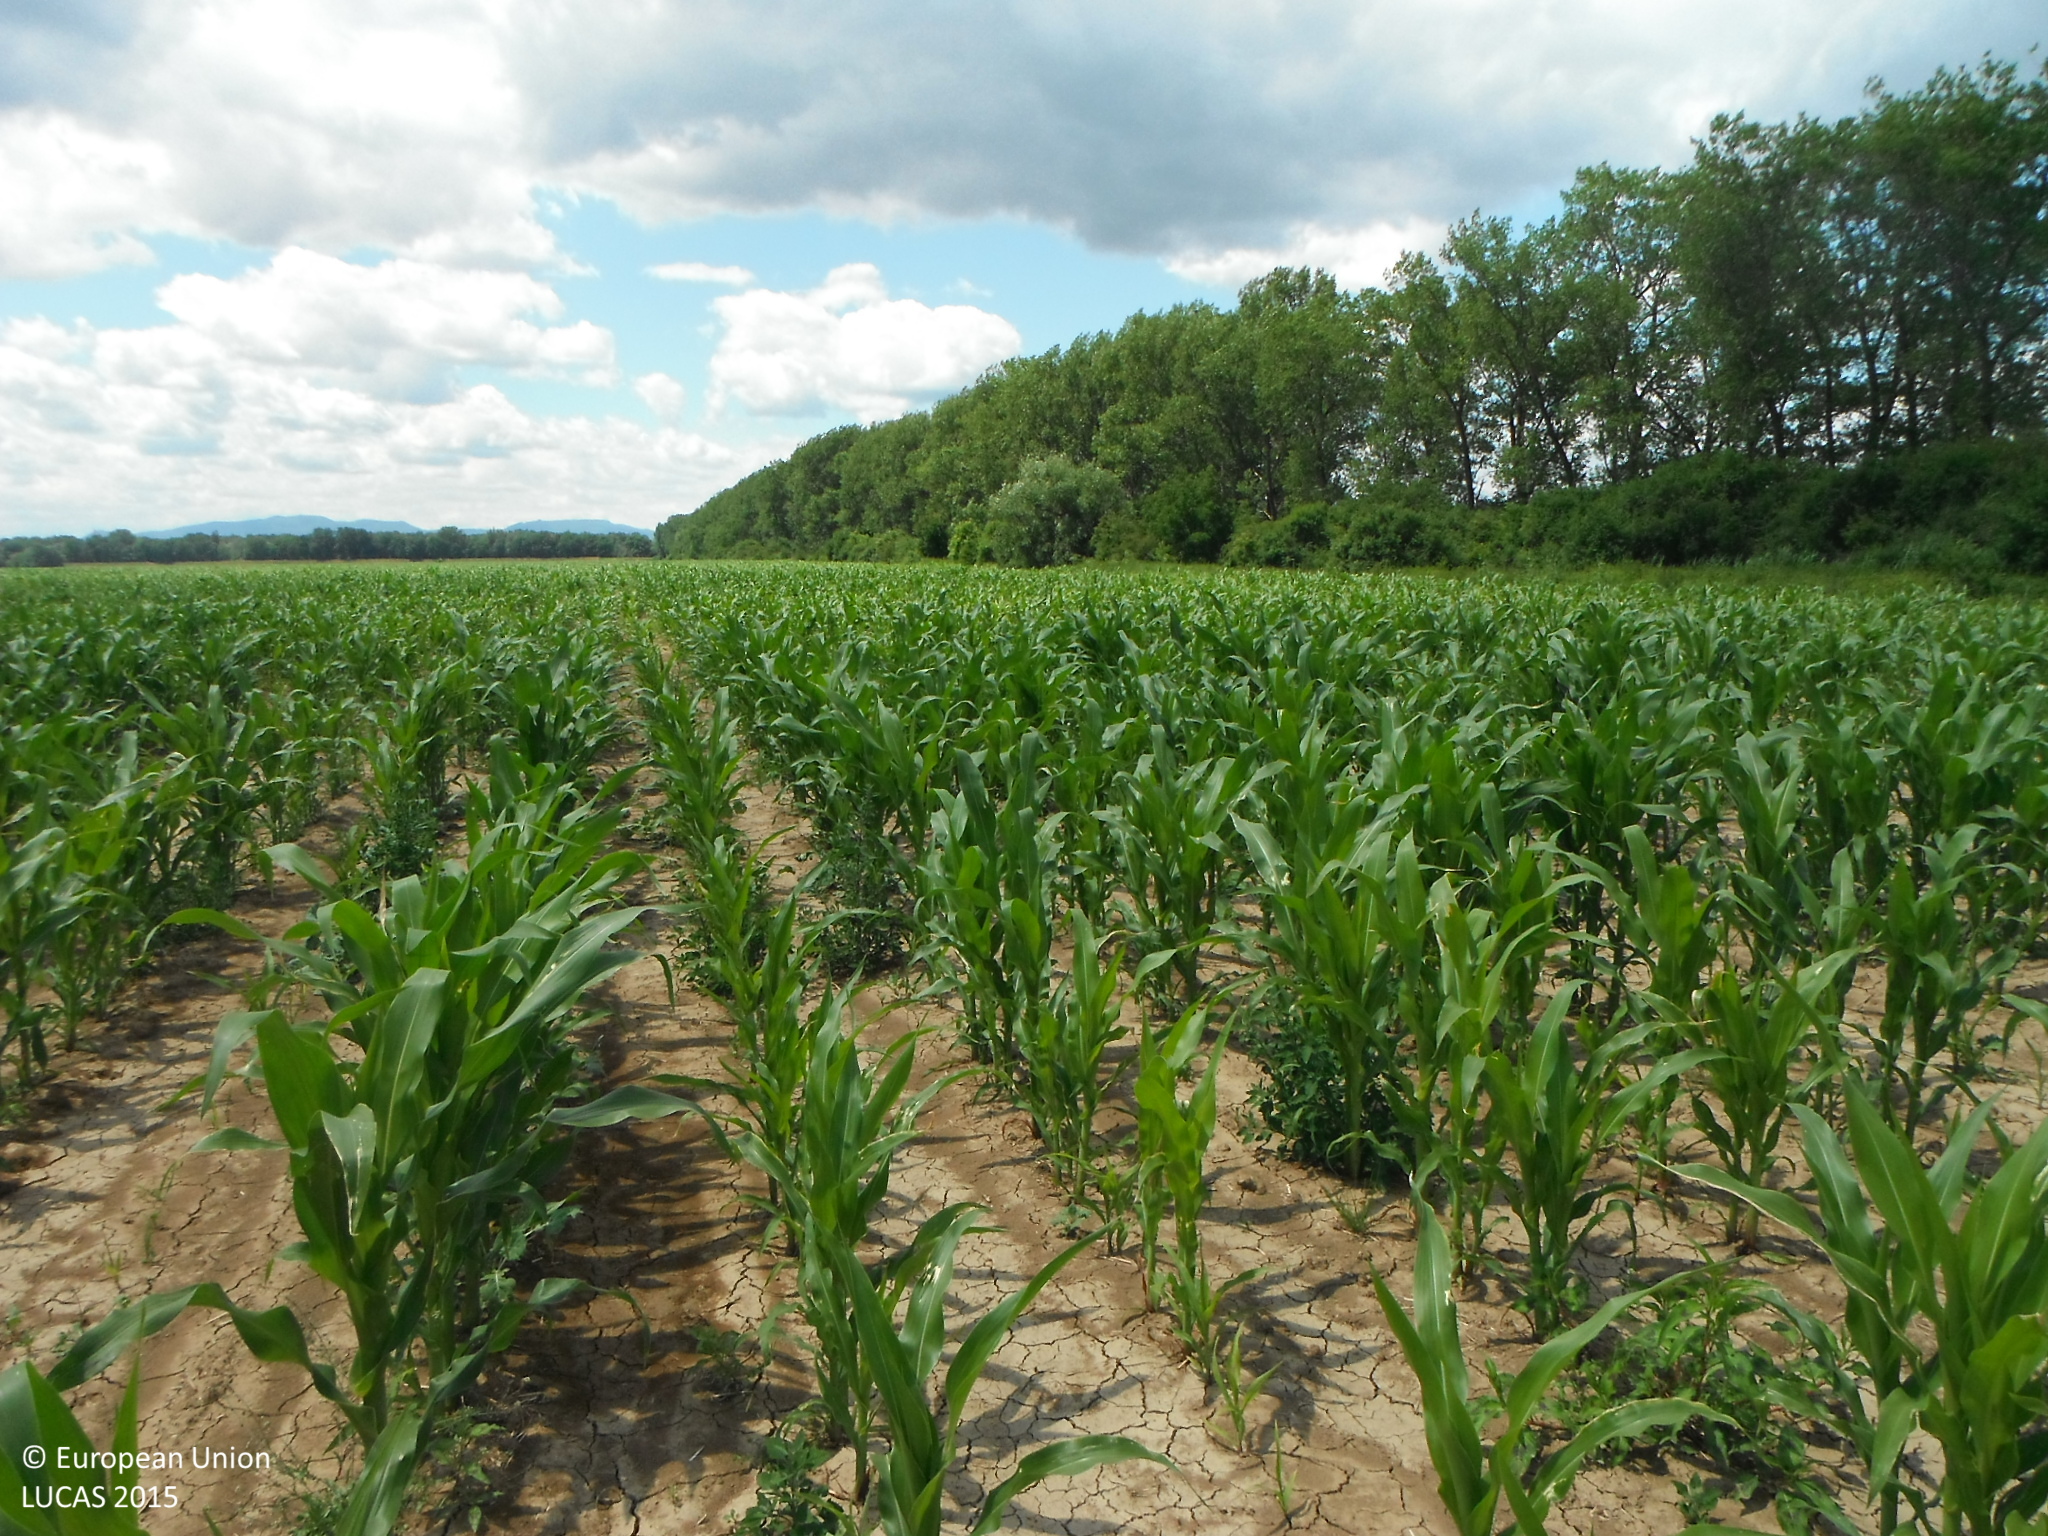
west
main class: Cropland
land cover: Maize
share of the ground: 25 - 50 %
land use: Agriculture (excluding fallow land and kitchen gardens)
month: June
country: SK
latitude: 48.6782
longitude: 21.7997
